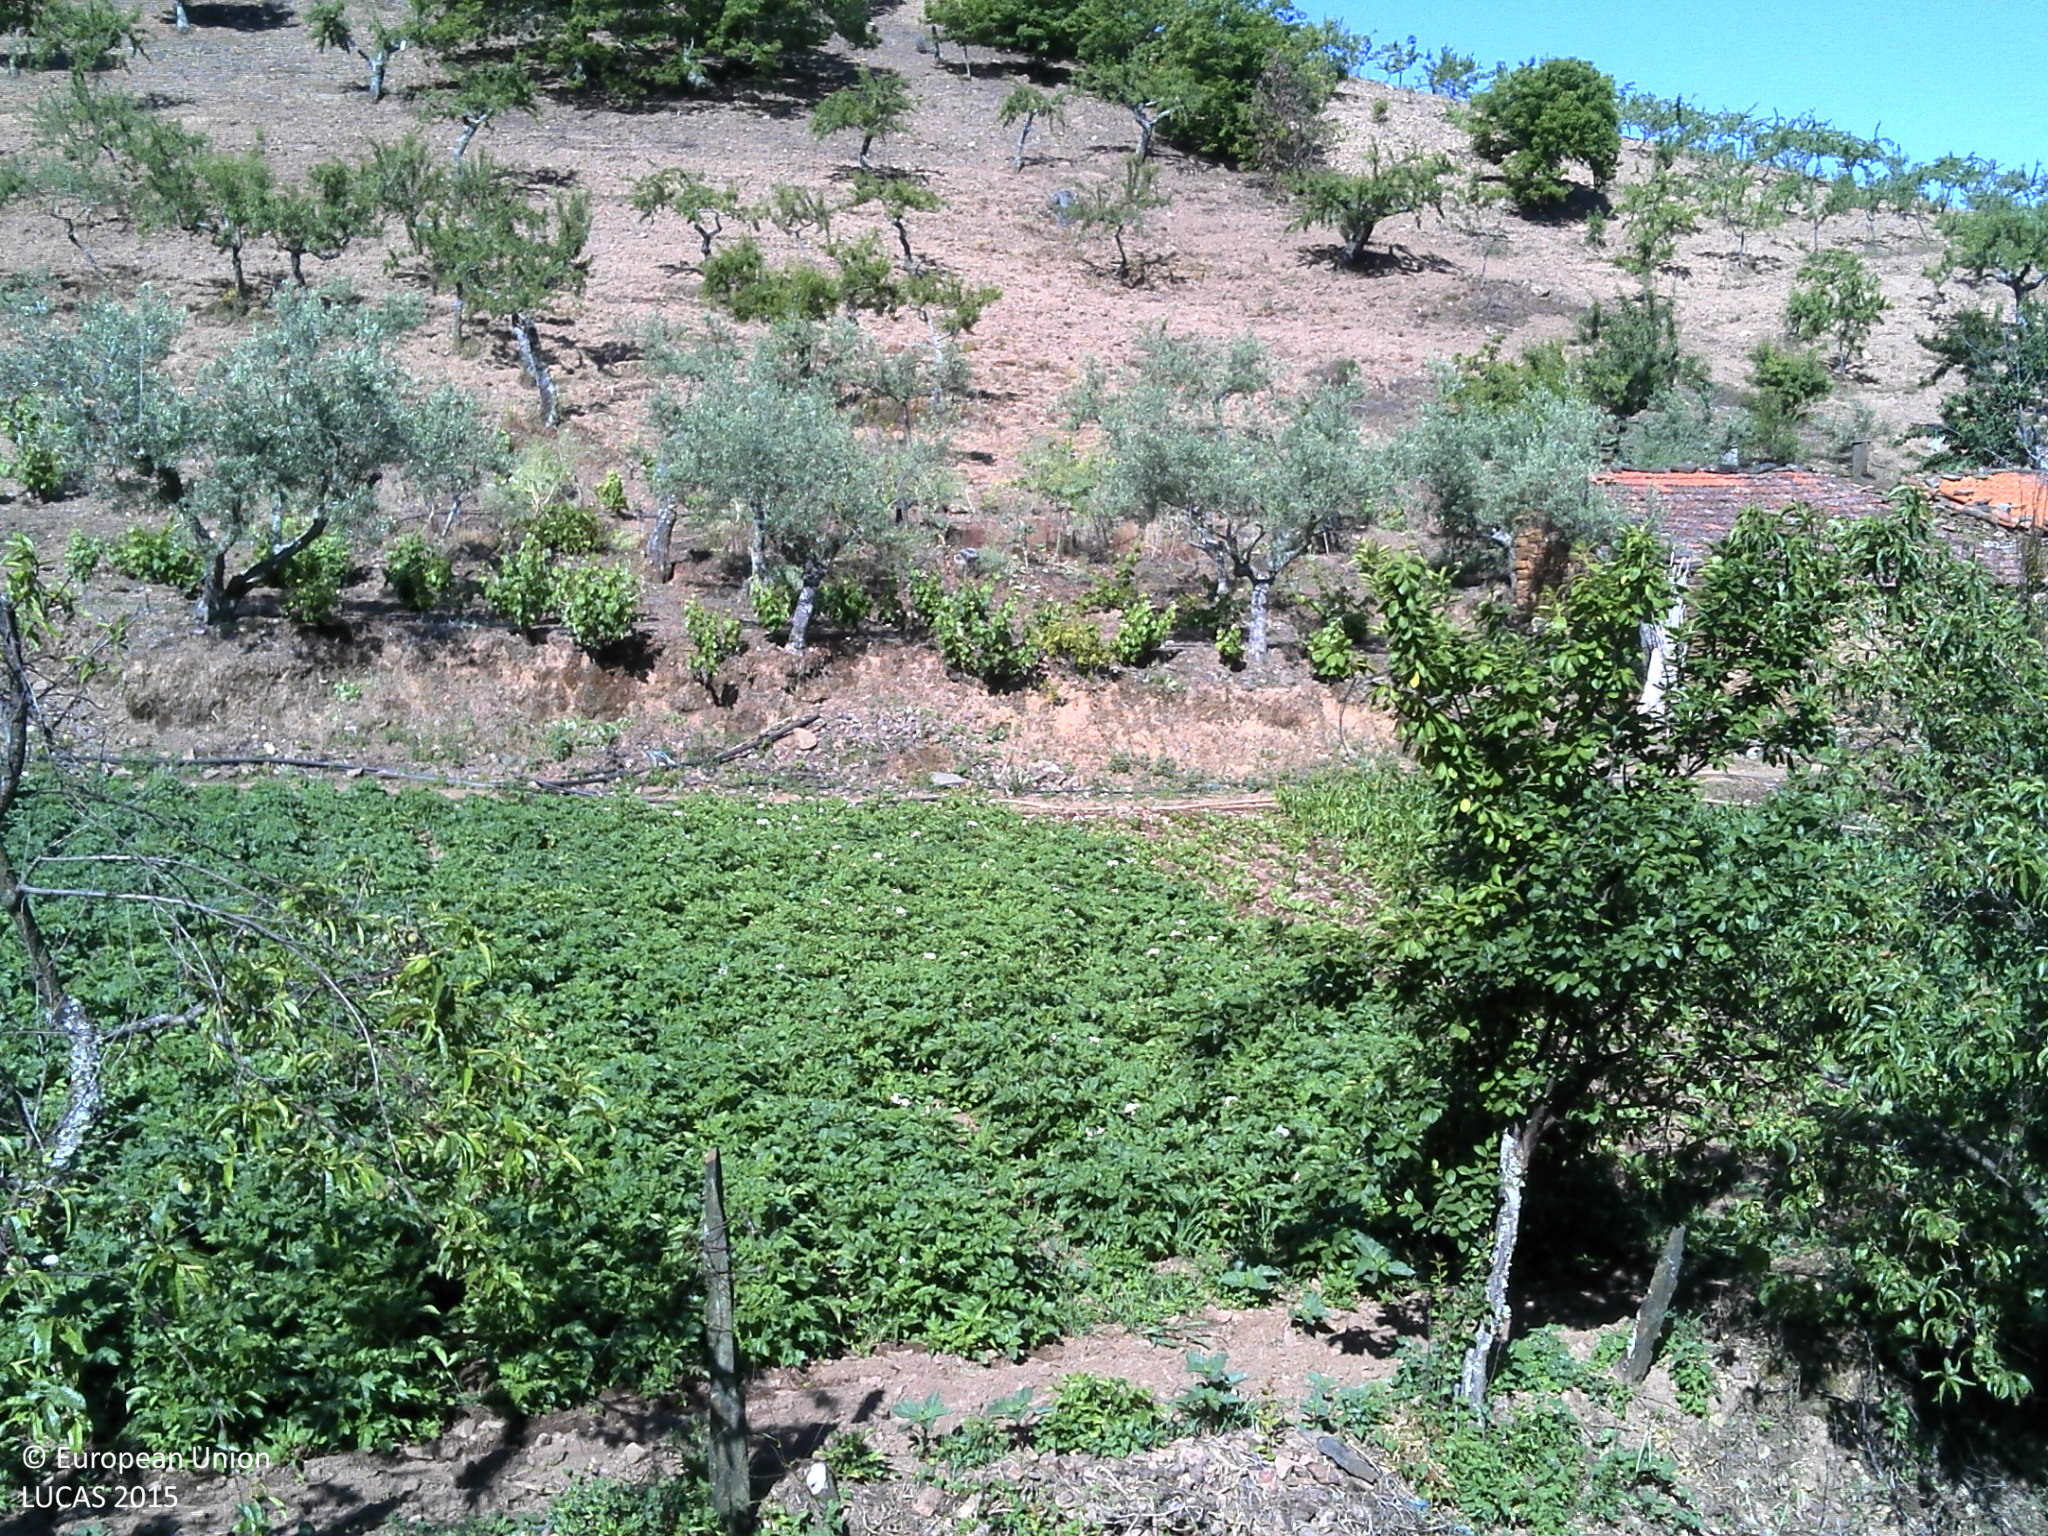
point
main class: Cropland
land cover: Olive groves
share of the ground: 25 - 50 %
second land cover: Vineyards
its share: < 10 %
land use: Agriculture (excluding fallow land and kitchen gardens)
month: May
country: PT
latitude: 41.1057
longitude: -6.9322
